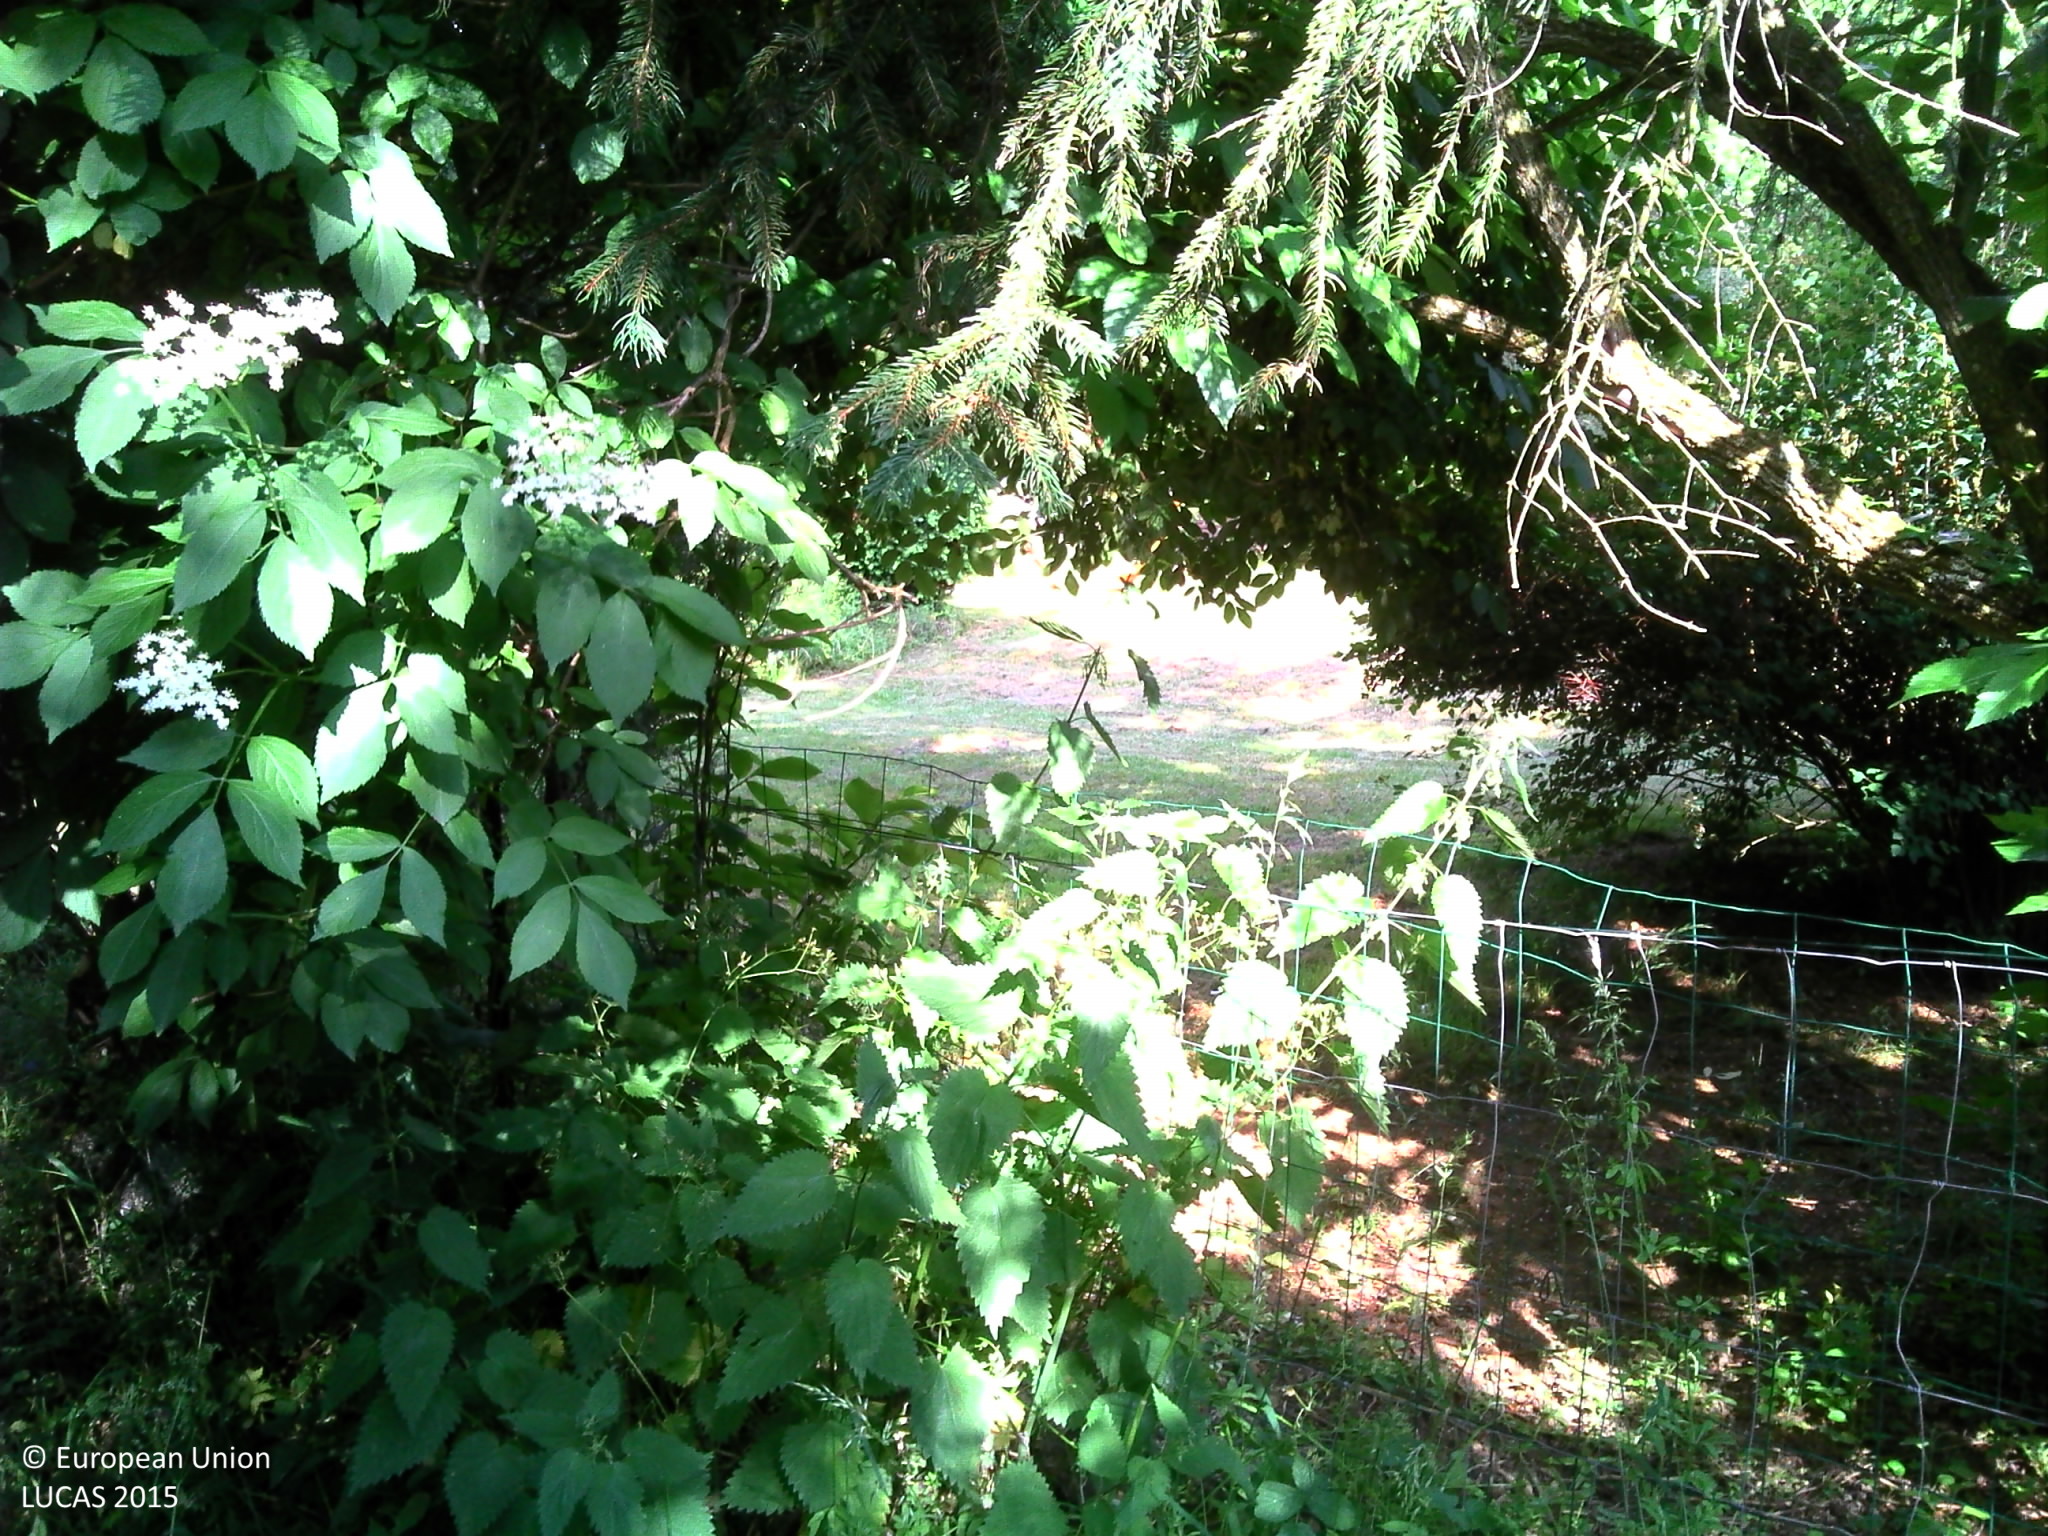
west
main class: Grassland
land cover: Grassland with sparse tree/shrub cover
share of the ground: > 75 %
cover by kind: herbaceous plants 95 %, broadleaved forest trees 5 %
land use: Residential
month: June
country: FR
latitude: 48.7554
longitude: 6.2867
